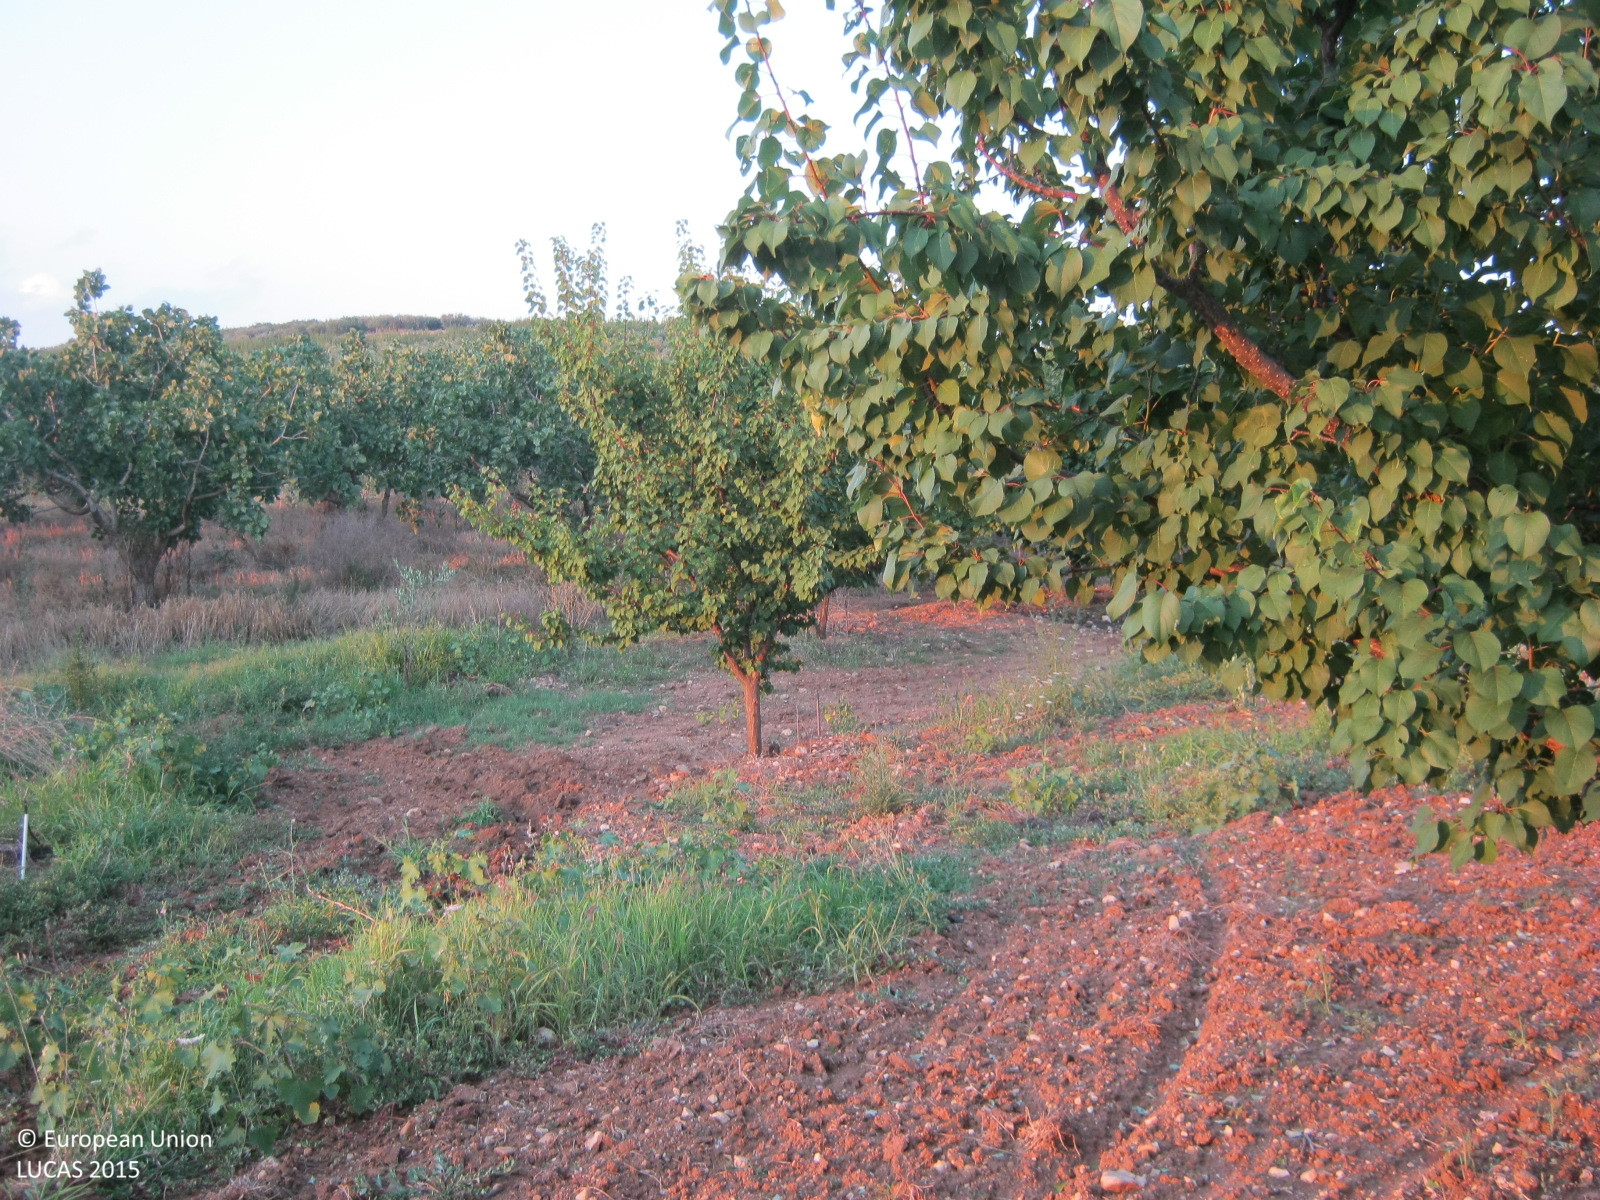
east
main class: Cropland
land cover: Other fruit trees and berries
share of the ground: 50 - 75 %
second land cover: Spontaneously vegetated surfaces
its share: 50 - 75 %
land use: Agriculture (excluding fallow land and kitchen gardens)
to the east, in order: Other fruit trees and berries; Spontaneously vegetated surfaces; Tracks; Nuts trees; Tracks; Other fruit trees and berries; Tracks; Other fruit trees and berries
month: July
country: GR
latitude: 40.2895
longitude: 23.3114
